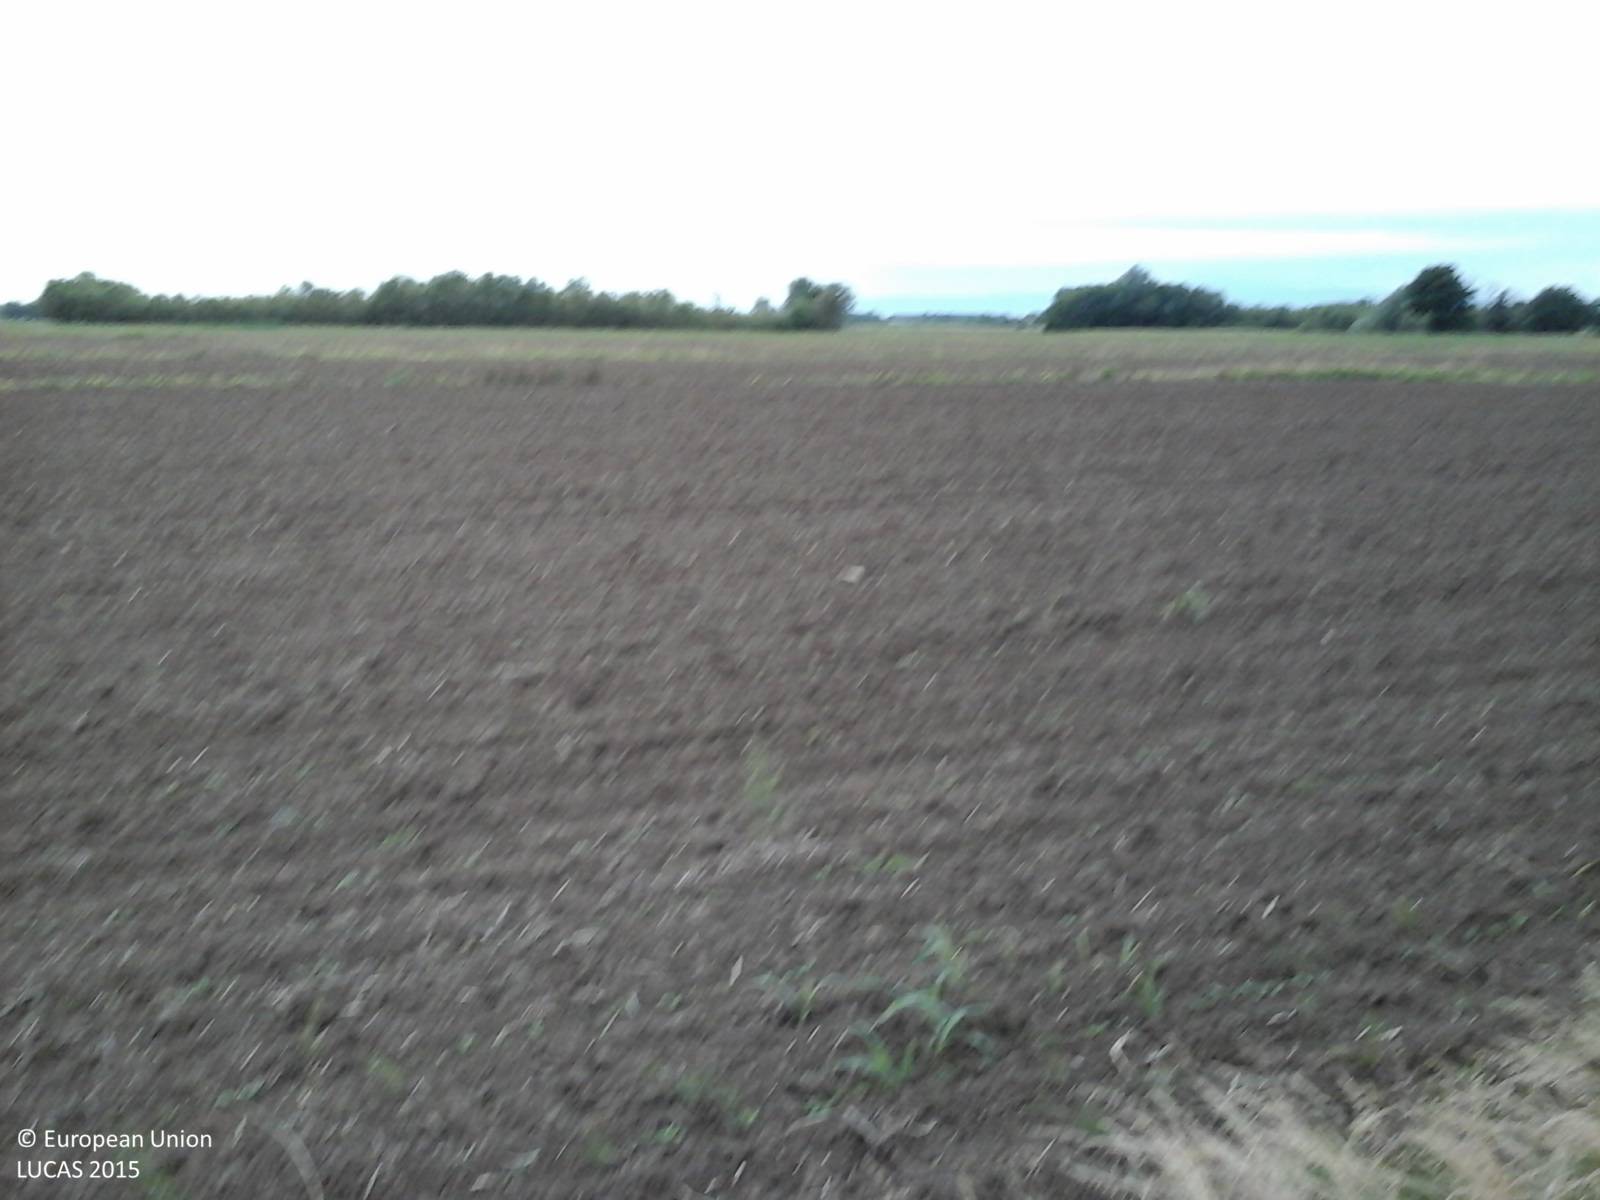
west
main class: Cropland
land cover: Soya
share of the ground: < 10 %
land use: Agriculture (excluding fallow land and kitchen gardens)
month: May
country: IT
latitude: 45.8009
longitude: 13.1226
